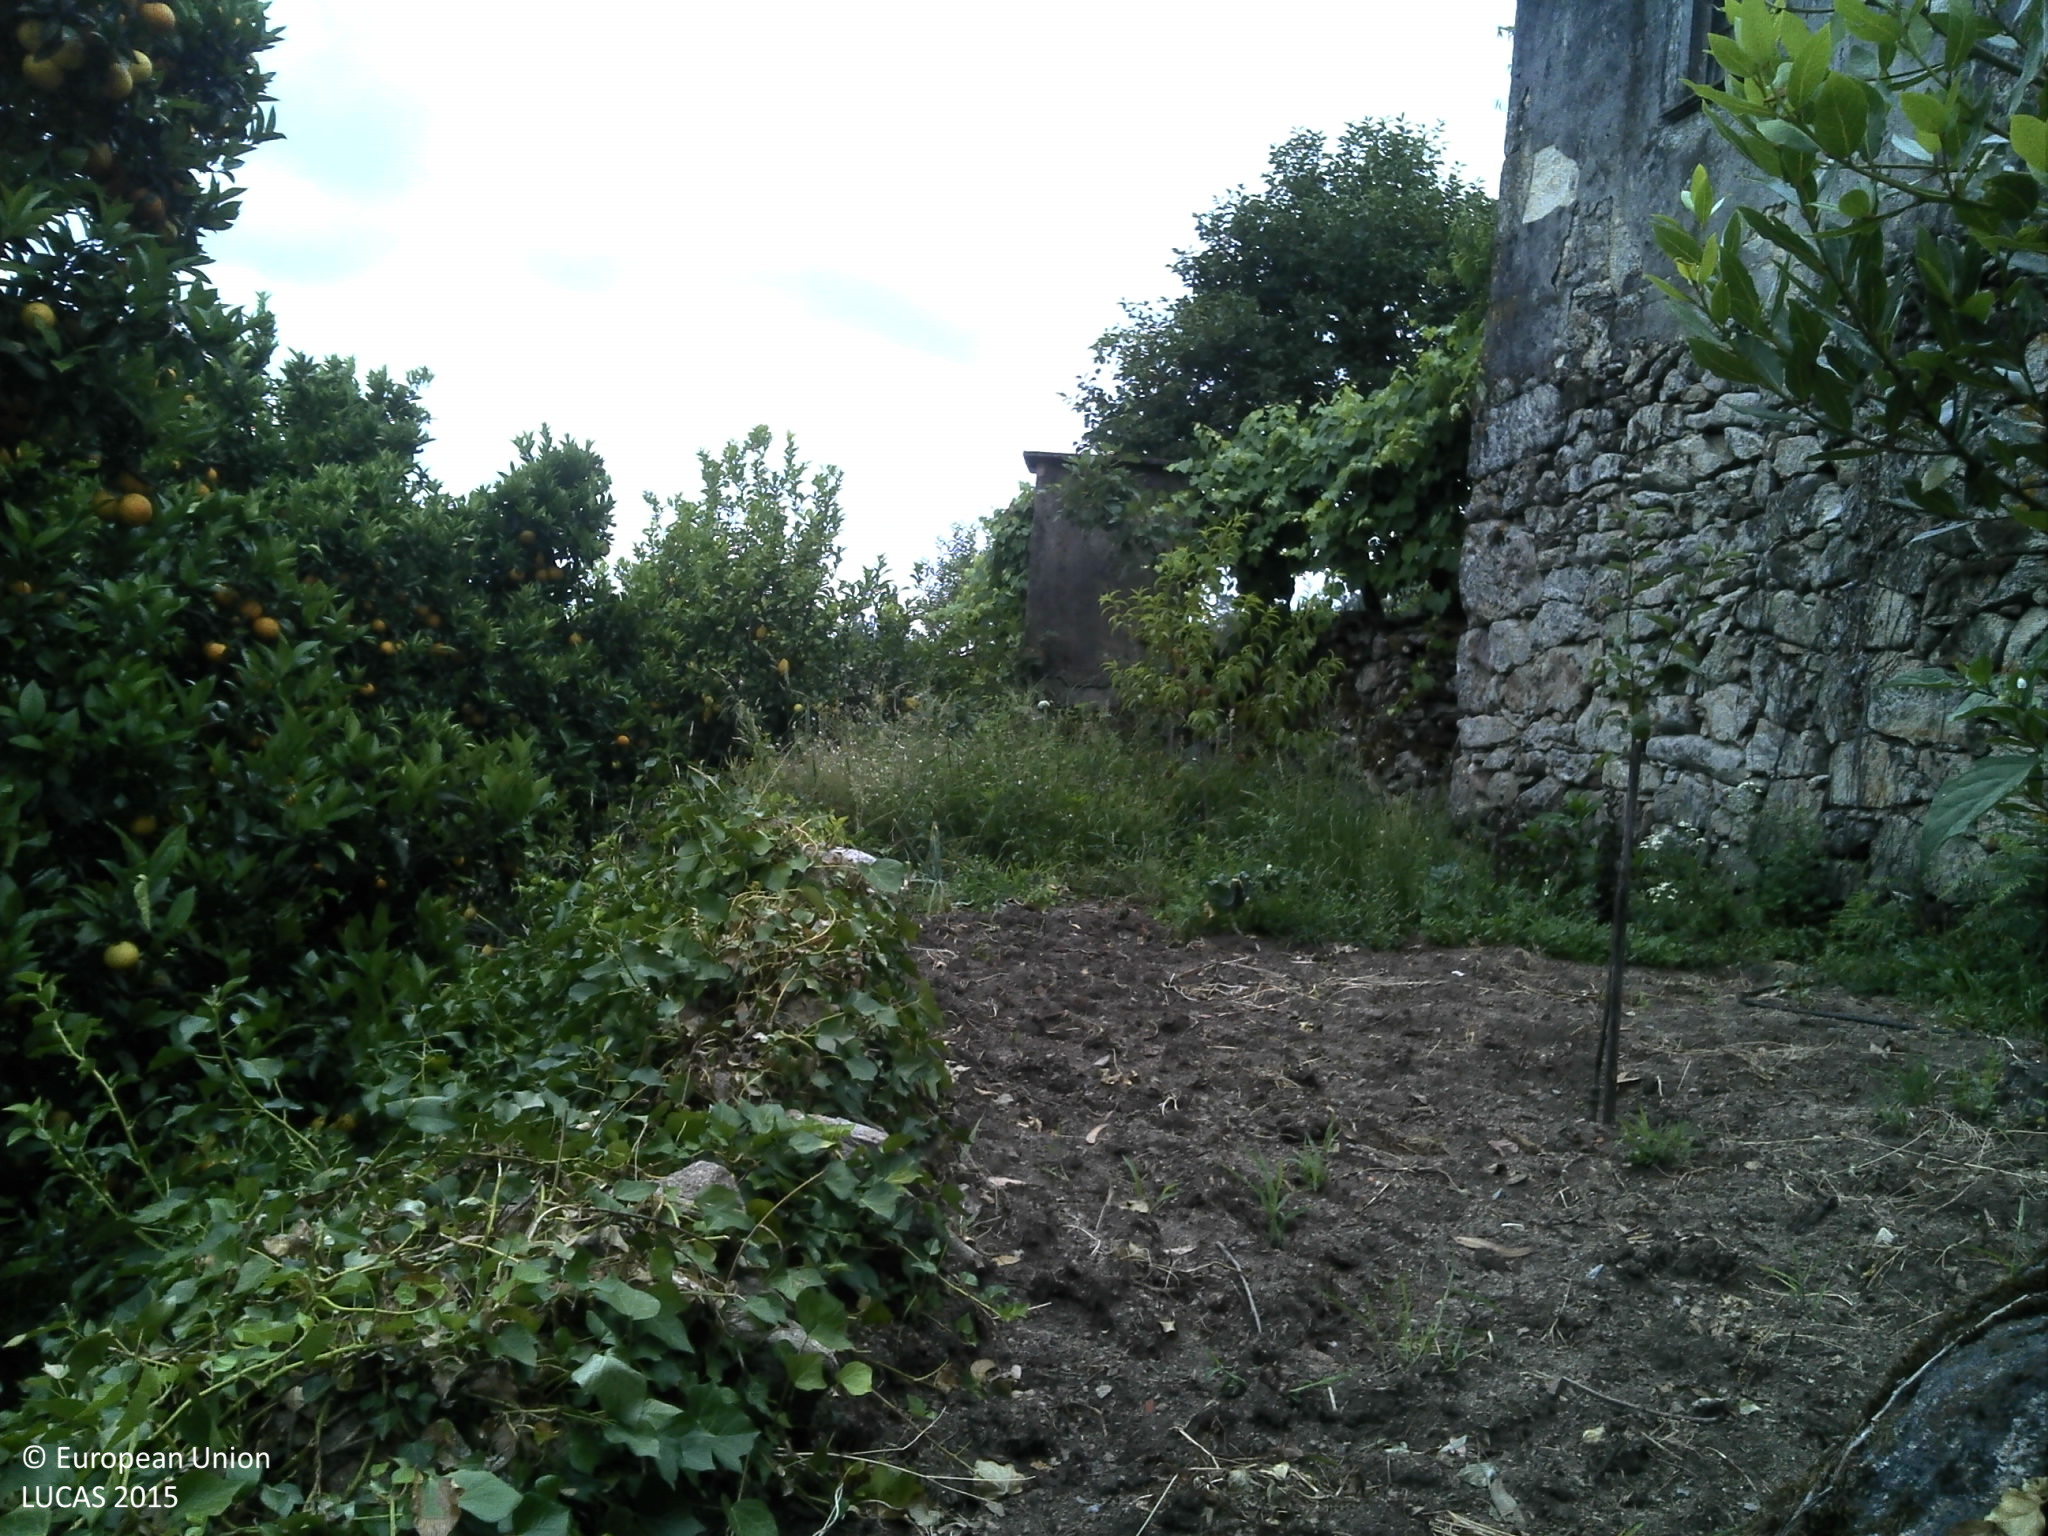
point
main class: Grassland
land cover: Grassland without tree/shrub cover
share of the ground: 50 - 75 %
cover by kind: herbaceous plants 75 %, unconsolidated bare surface 25 %
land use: Agriculture (excluding fallow land and kitchen gardens)
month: June
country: PT
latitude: 40.7844
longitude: -8.3033
